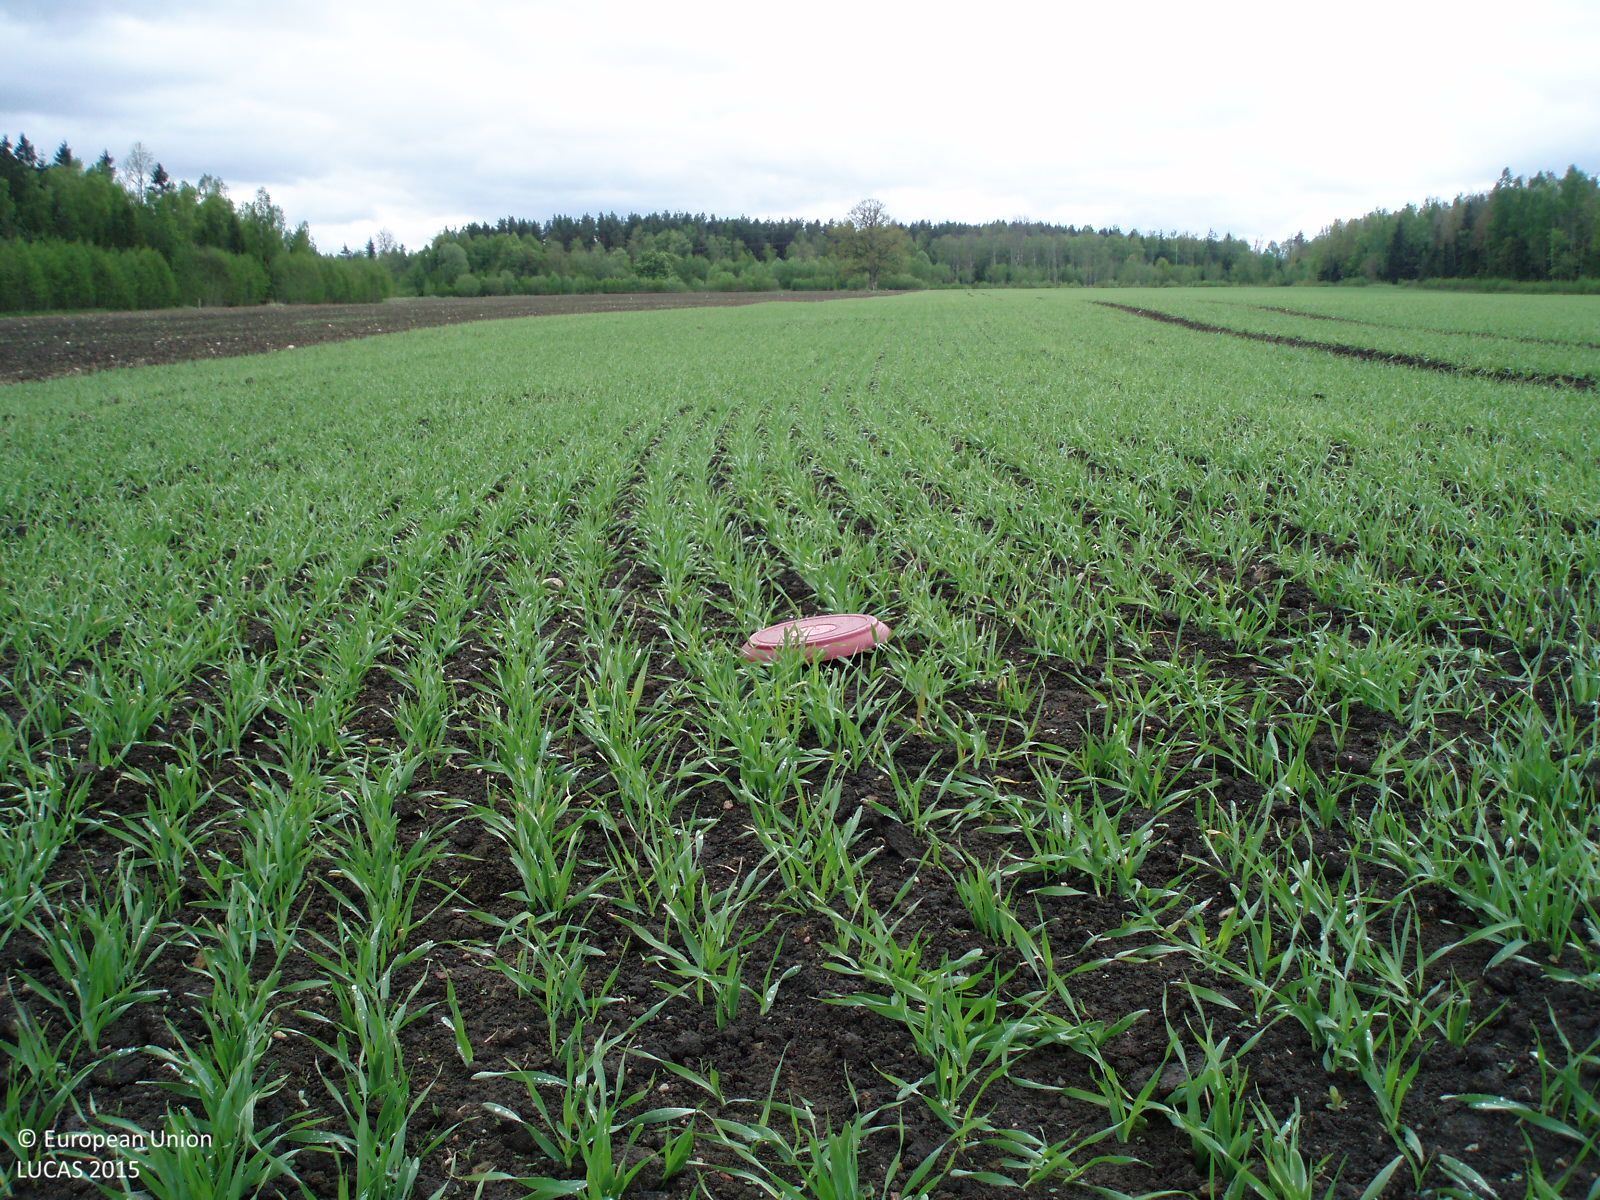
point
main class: Cropland
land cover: Barley
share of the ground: 50 - 75 %
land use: Agriculture (excluding fallow land and kitchen gardens)
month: May
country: LT
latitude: 56.3327
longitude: 22.5616
